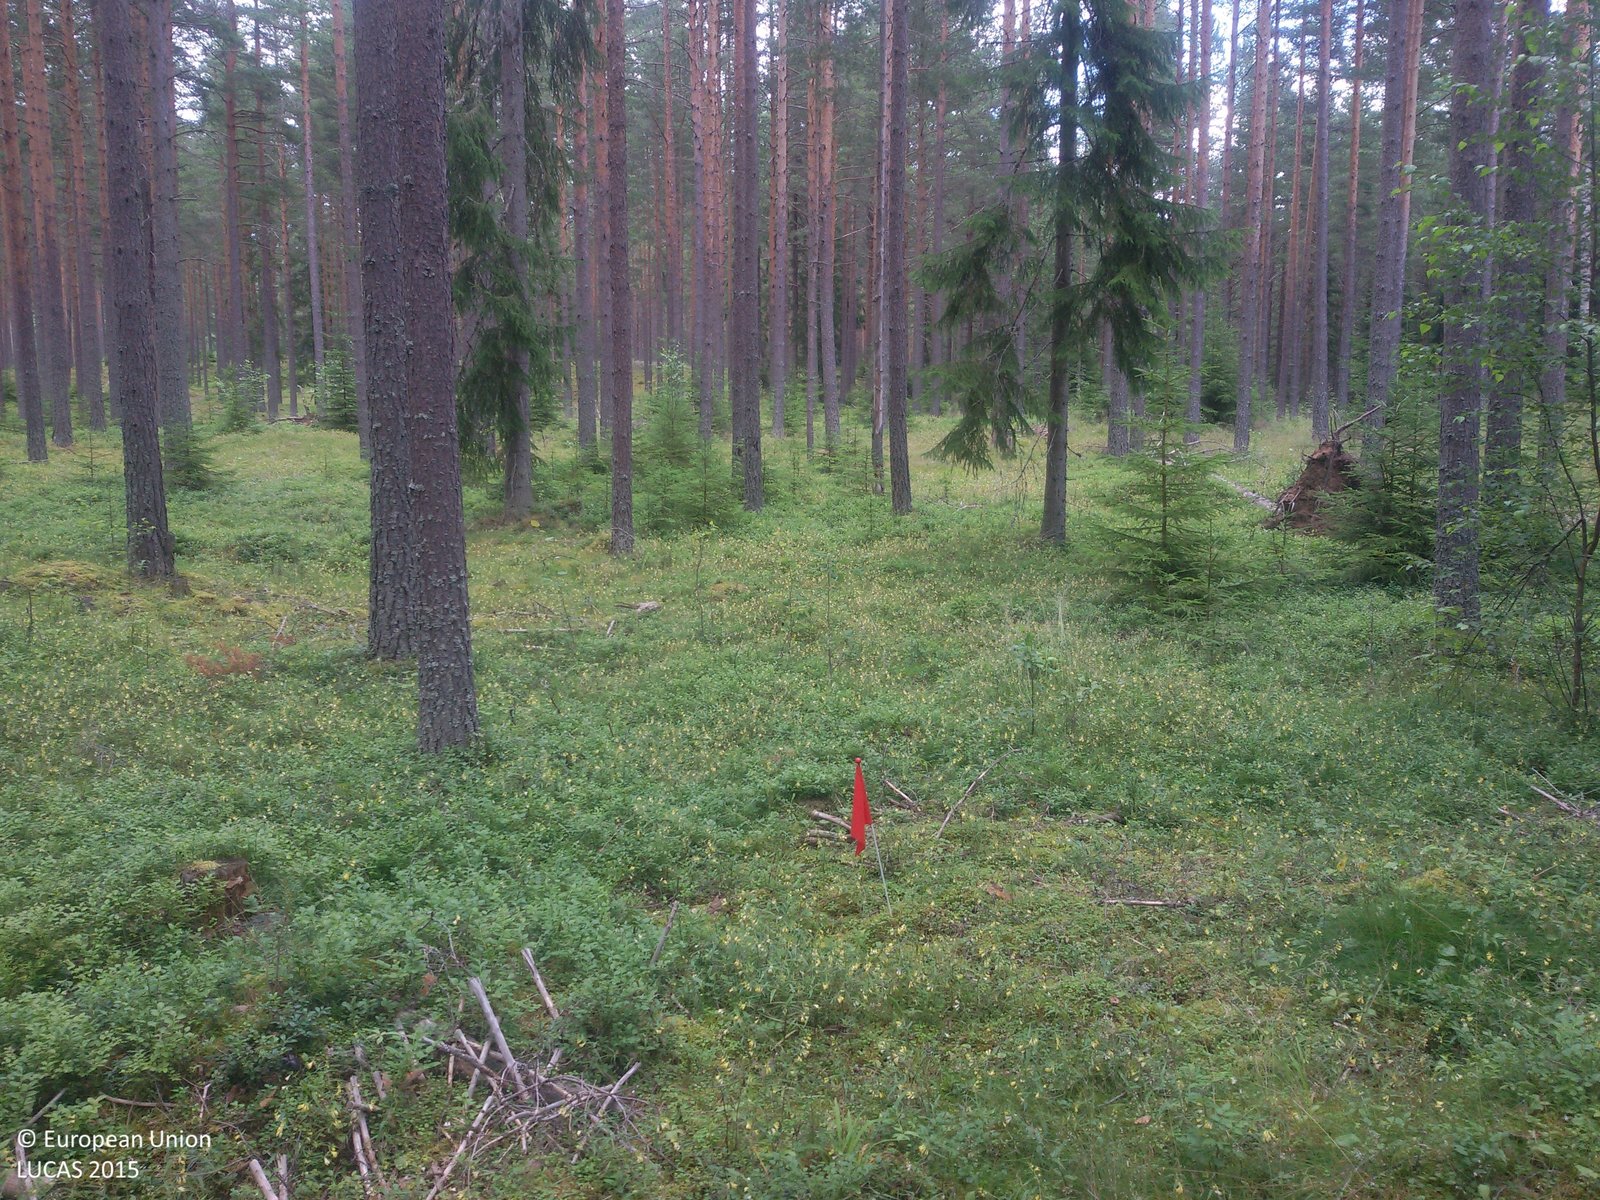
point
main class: Woodland
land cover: Pine dominated coniferous woodland
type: boreal forest
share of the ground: > 75 %
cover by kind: coniferous forest trees 65 %, shrubs 20 %, herbaceous plants 10 %, lichens and mosses 5 %
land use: Forestry
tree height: > 5 m
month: July
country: SE
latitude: 60.5313
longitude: 15.3270
